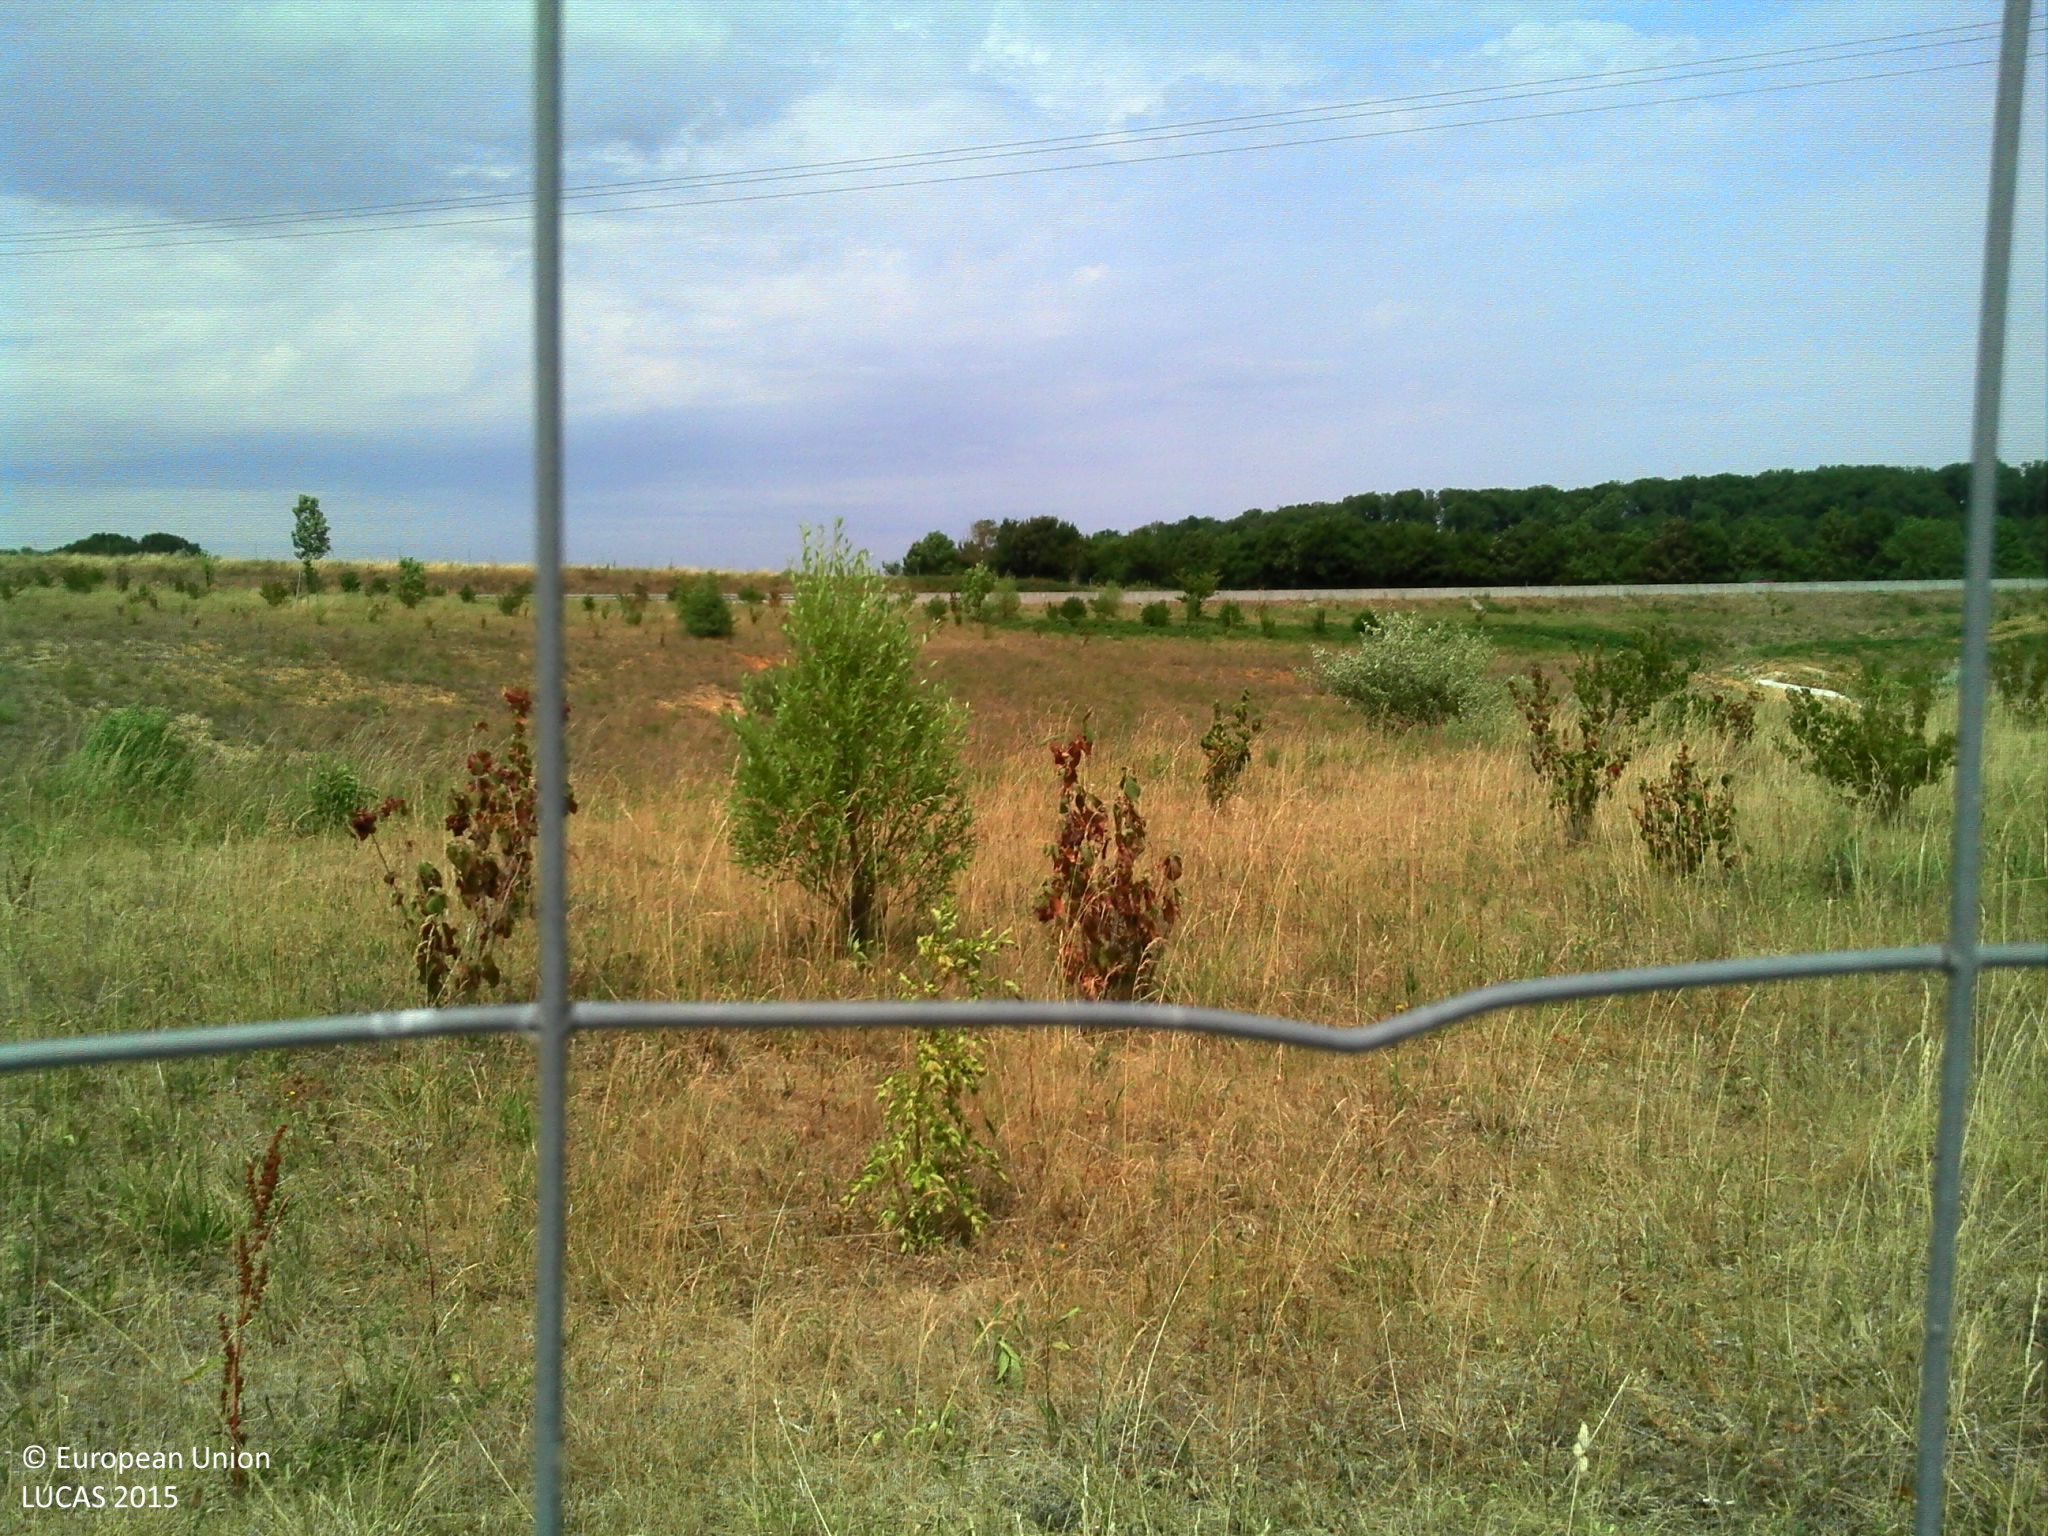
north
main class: Grassland
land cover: Grassland without tree/shrub cover
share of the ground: > 75 %
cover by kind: herbaceous plants 100 %
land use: Protection infrastructures
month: July
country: FR
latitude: 48.0391
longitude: 3.0318
